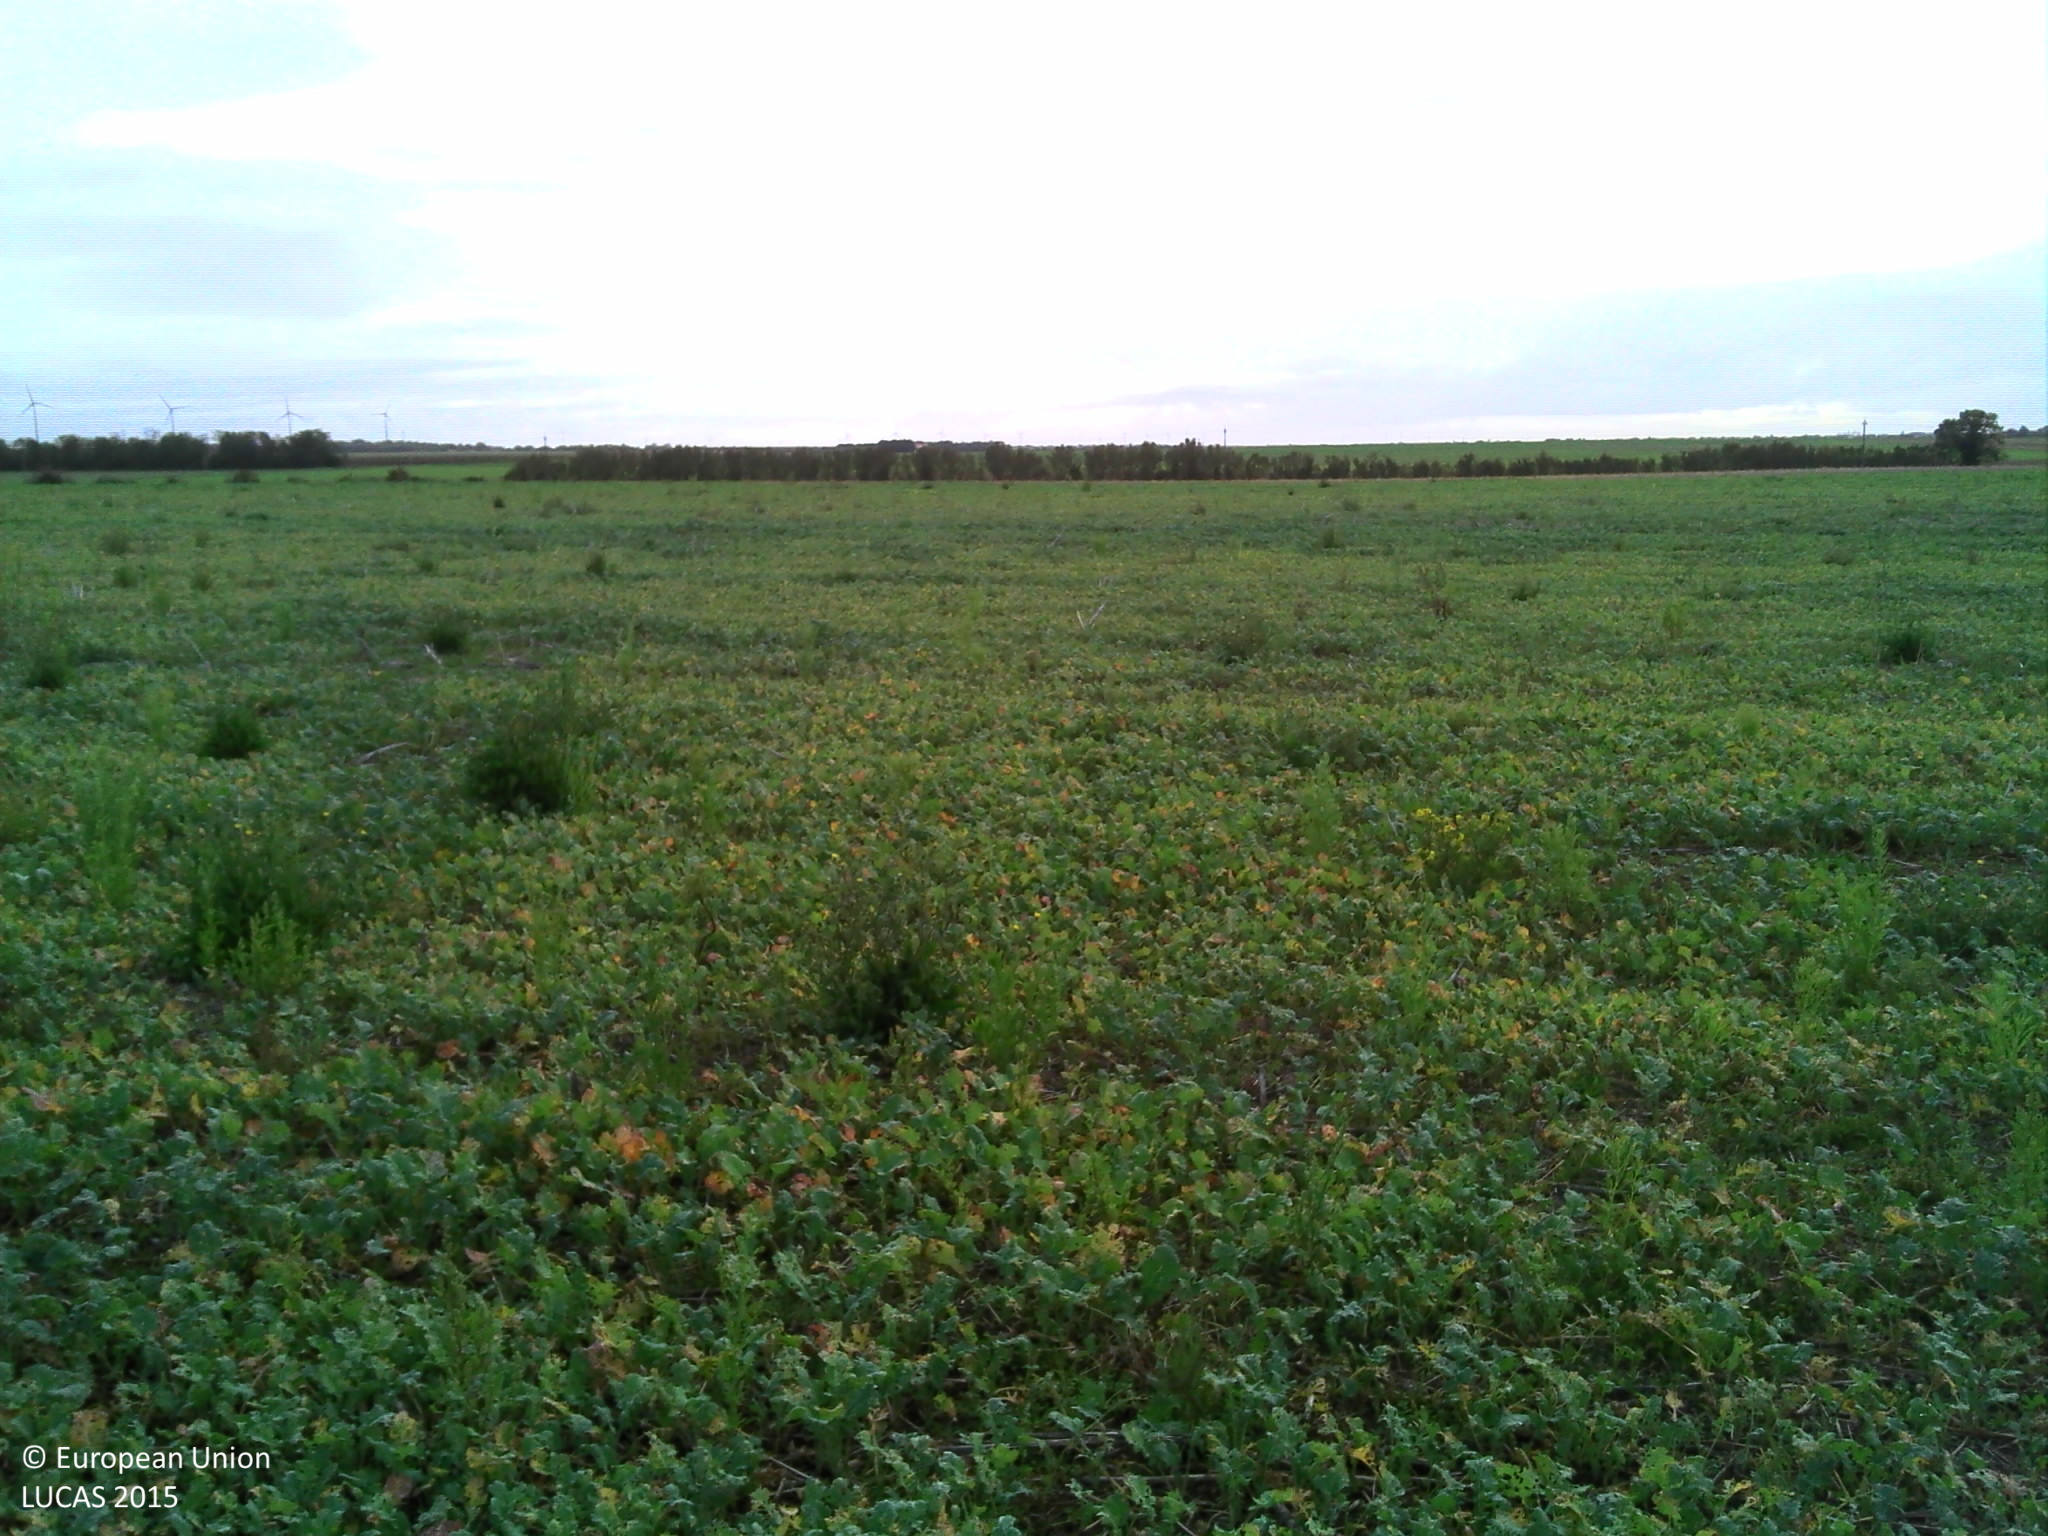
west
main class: Cropland
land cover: Rape and turnip rape
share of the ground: 50 - 75 %
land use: Agriculture (excluding fallow land and kitchen gardens)
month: October
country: FR
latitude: 46.4839
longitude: -1.0659
